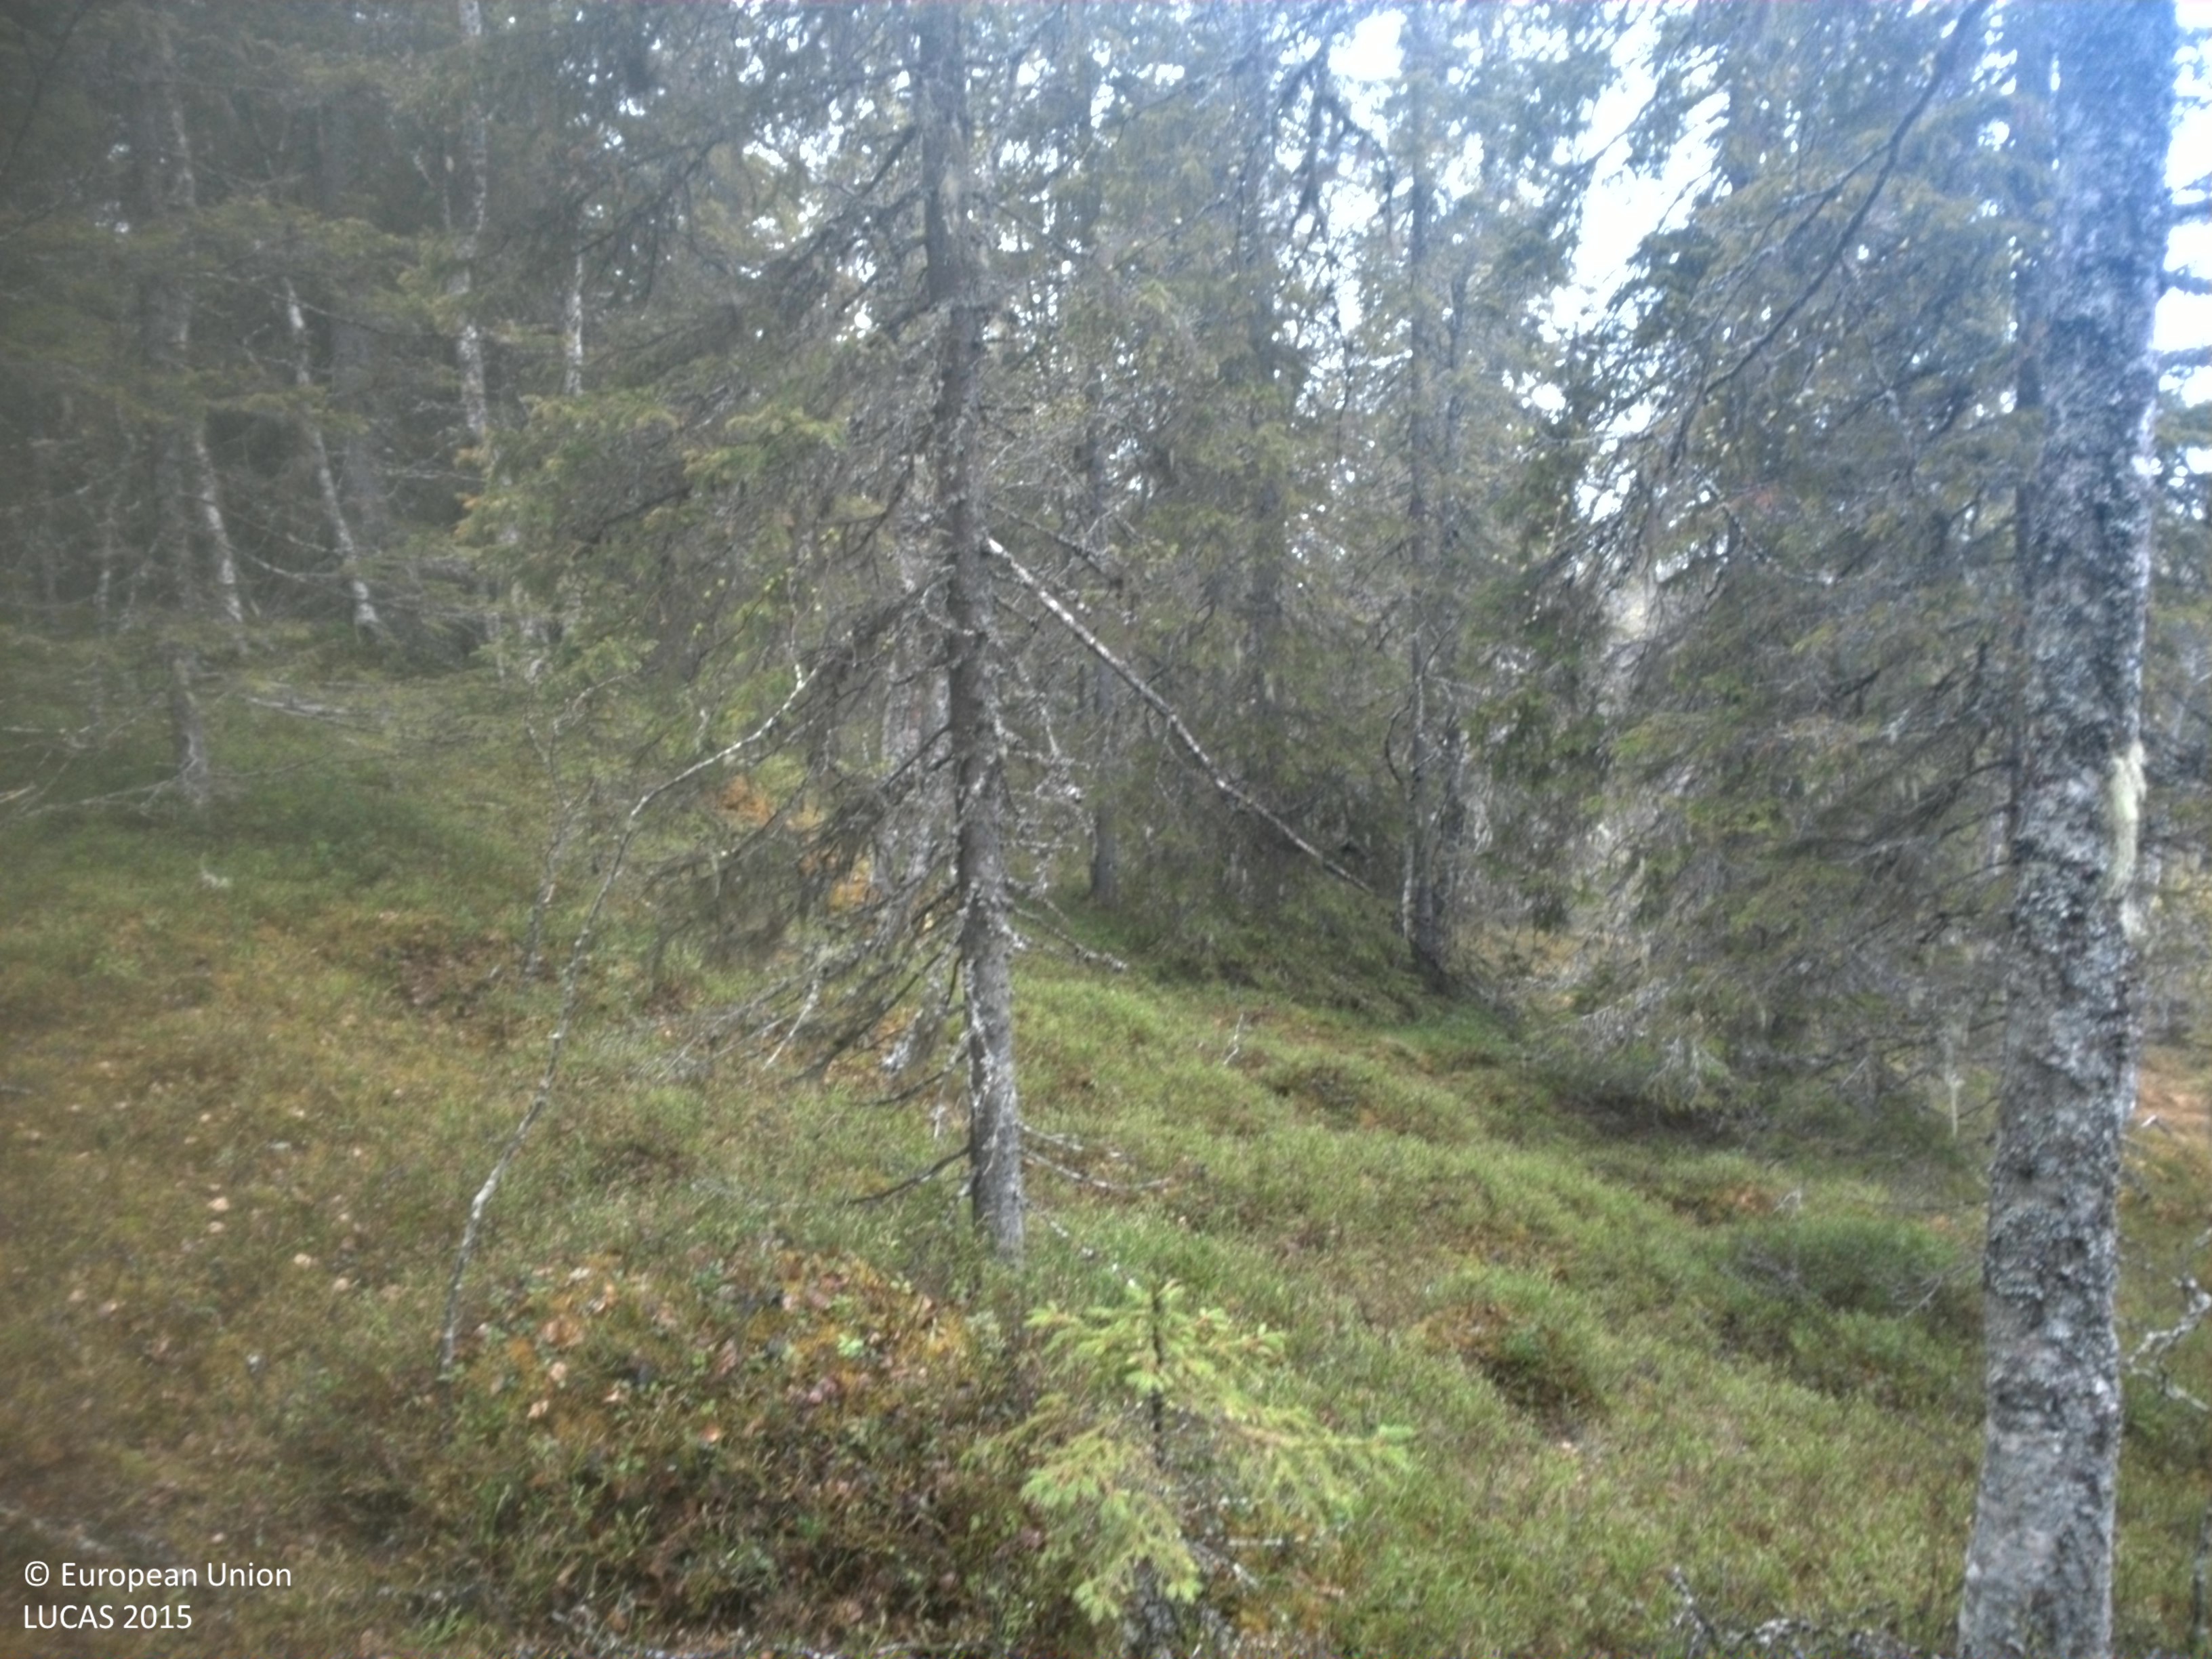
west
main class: Woodland
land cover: Spruce dominated coniferous woodland
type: boreal forest
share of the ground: 50 - 75 %
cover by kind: coniferous forest trees 50 %, herbaceous plants 20 %, lichens and mosses 15 %, broadleaved forest trees 10 %, shrubs 5 %
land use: Forestry
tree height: > 5 m
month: June
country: SE
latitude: 64.3722
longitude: 18.1123
